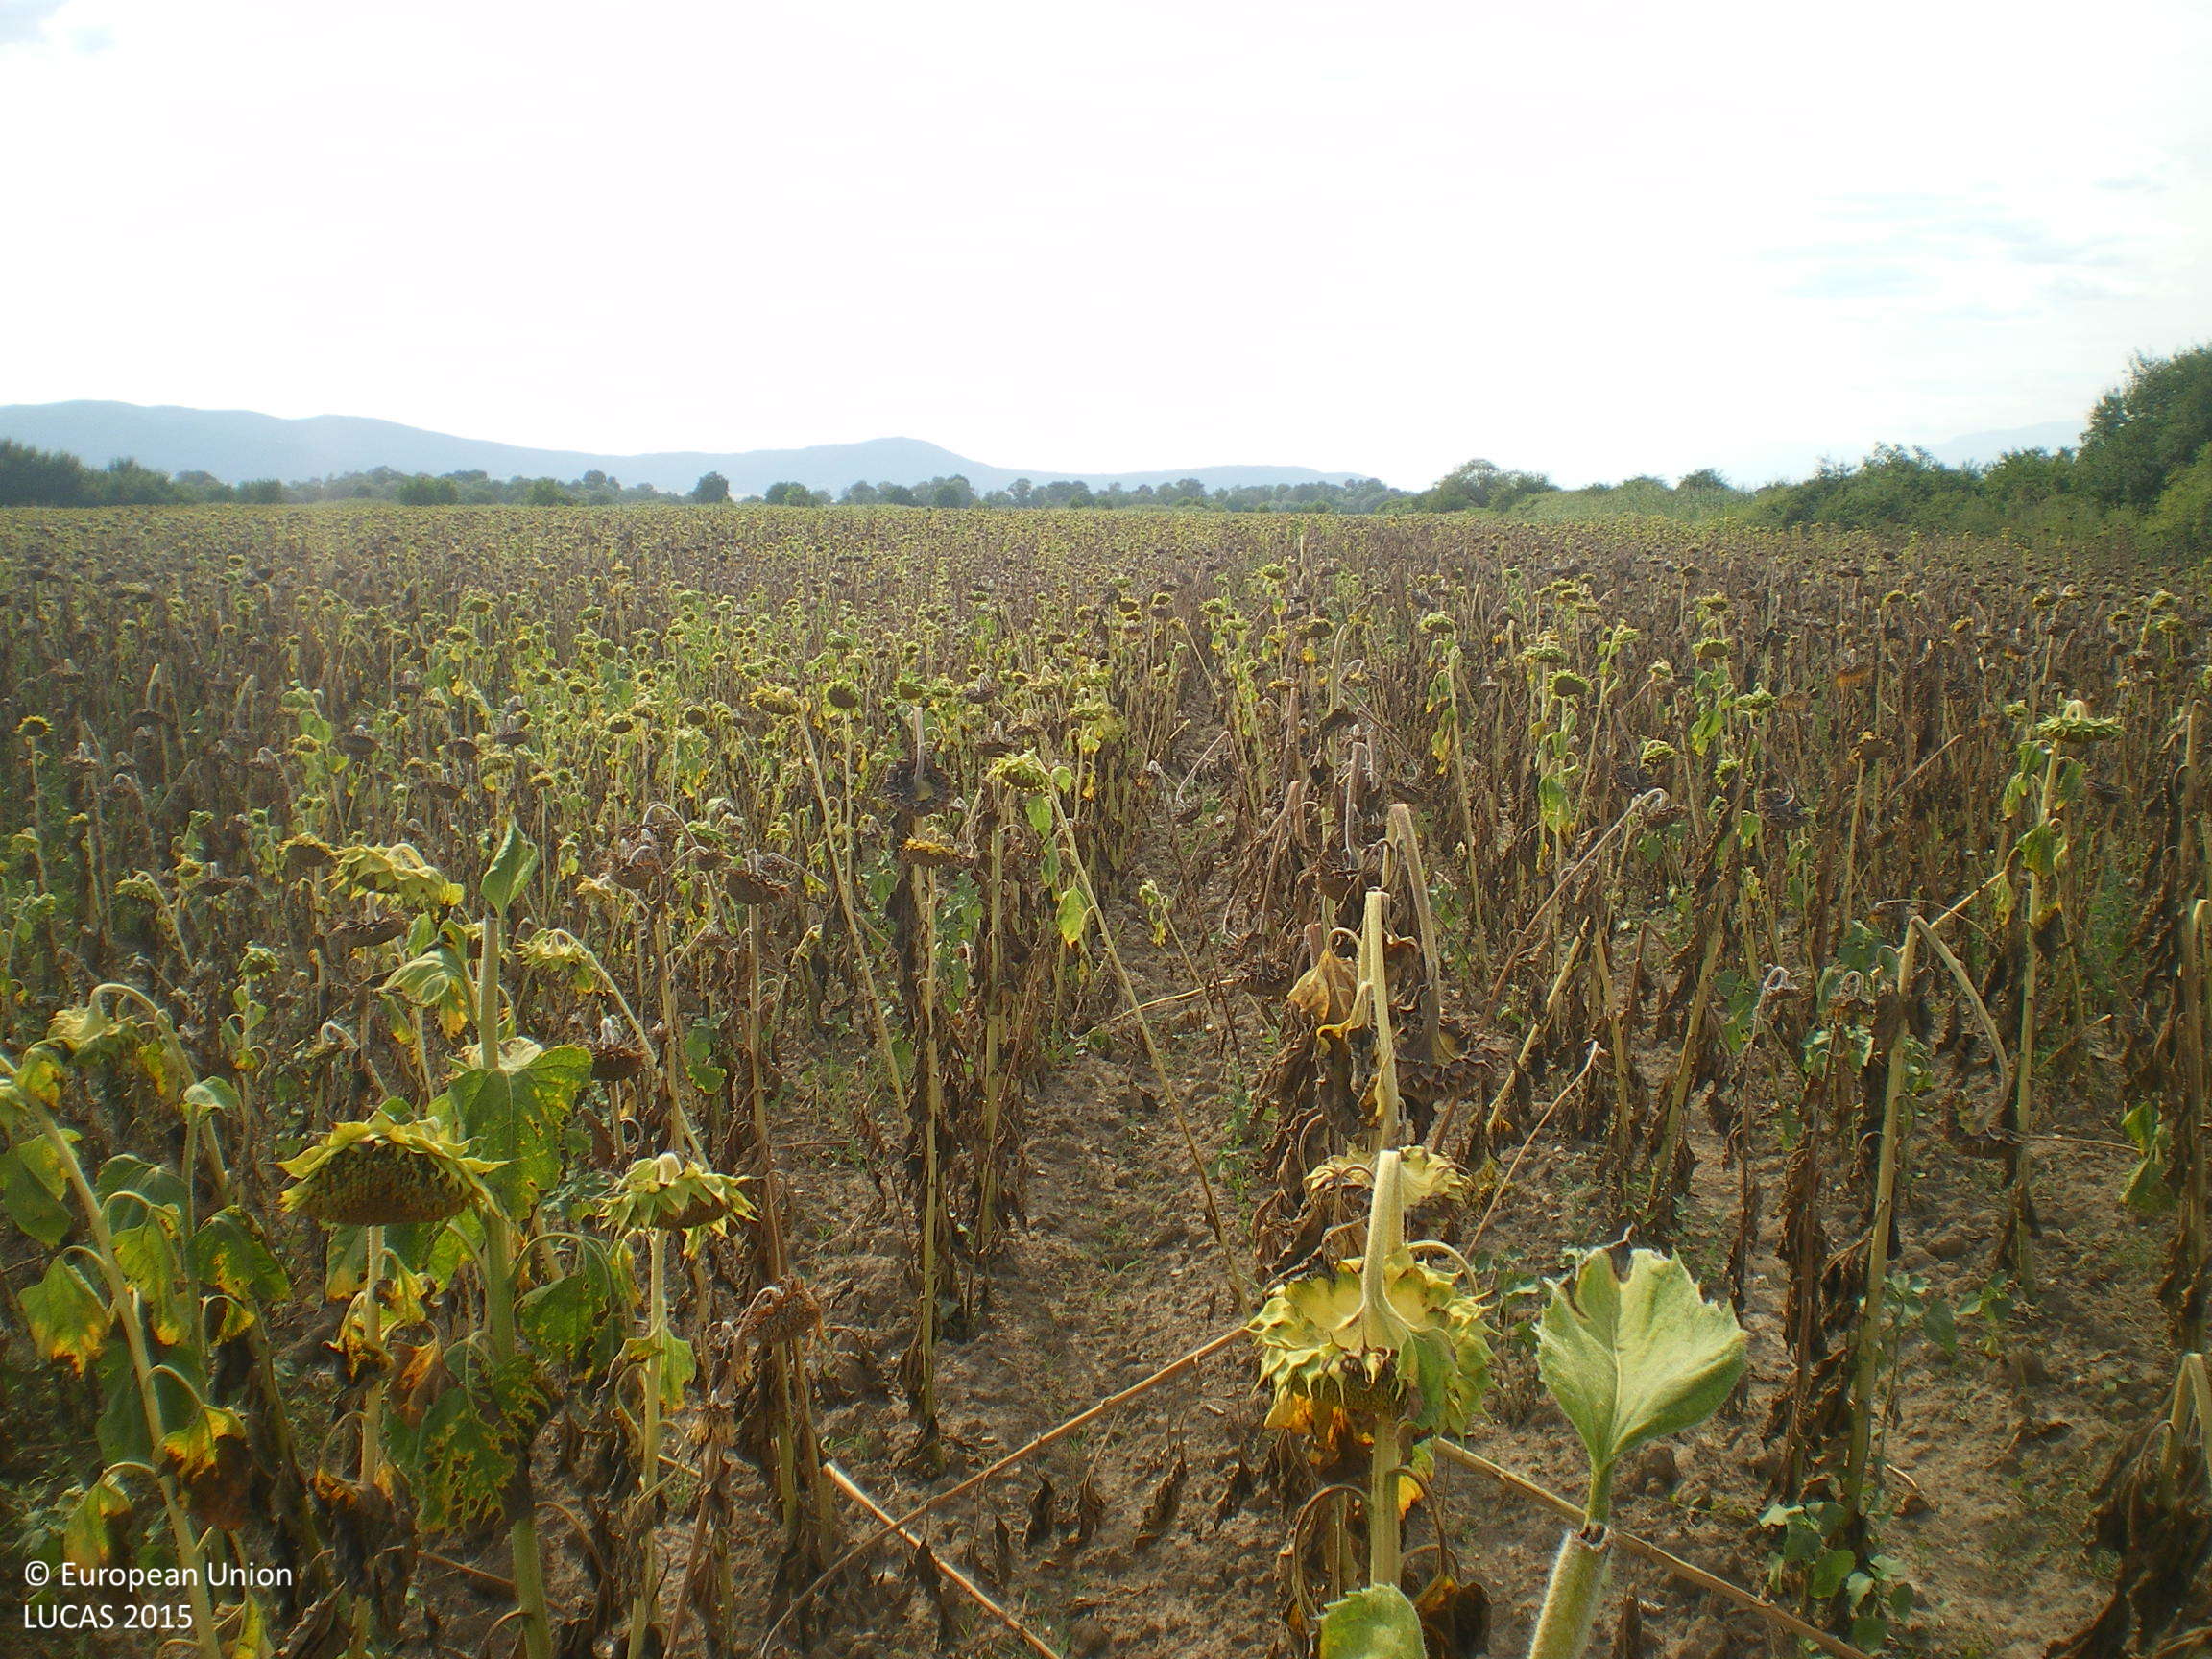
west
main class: Cropland
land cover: Sunflower
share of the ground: > 75 %
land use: Agriculture (excluding fallow land and kitchen gardens)
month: August
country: BG
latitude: 42.5497
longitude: 25.5254
